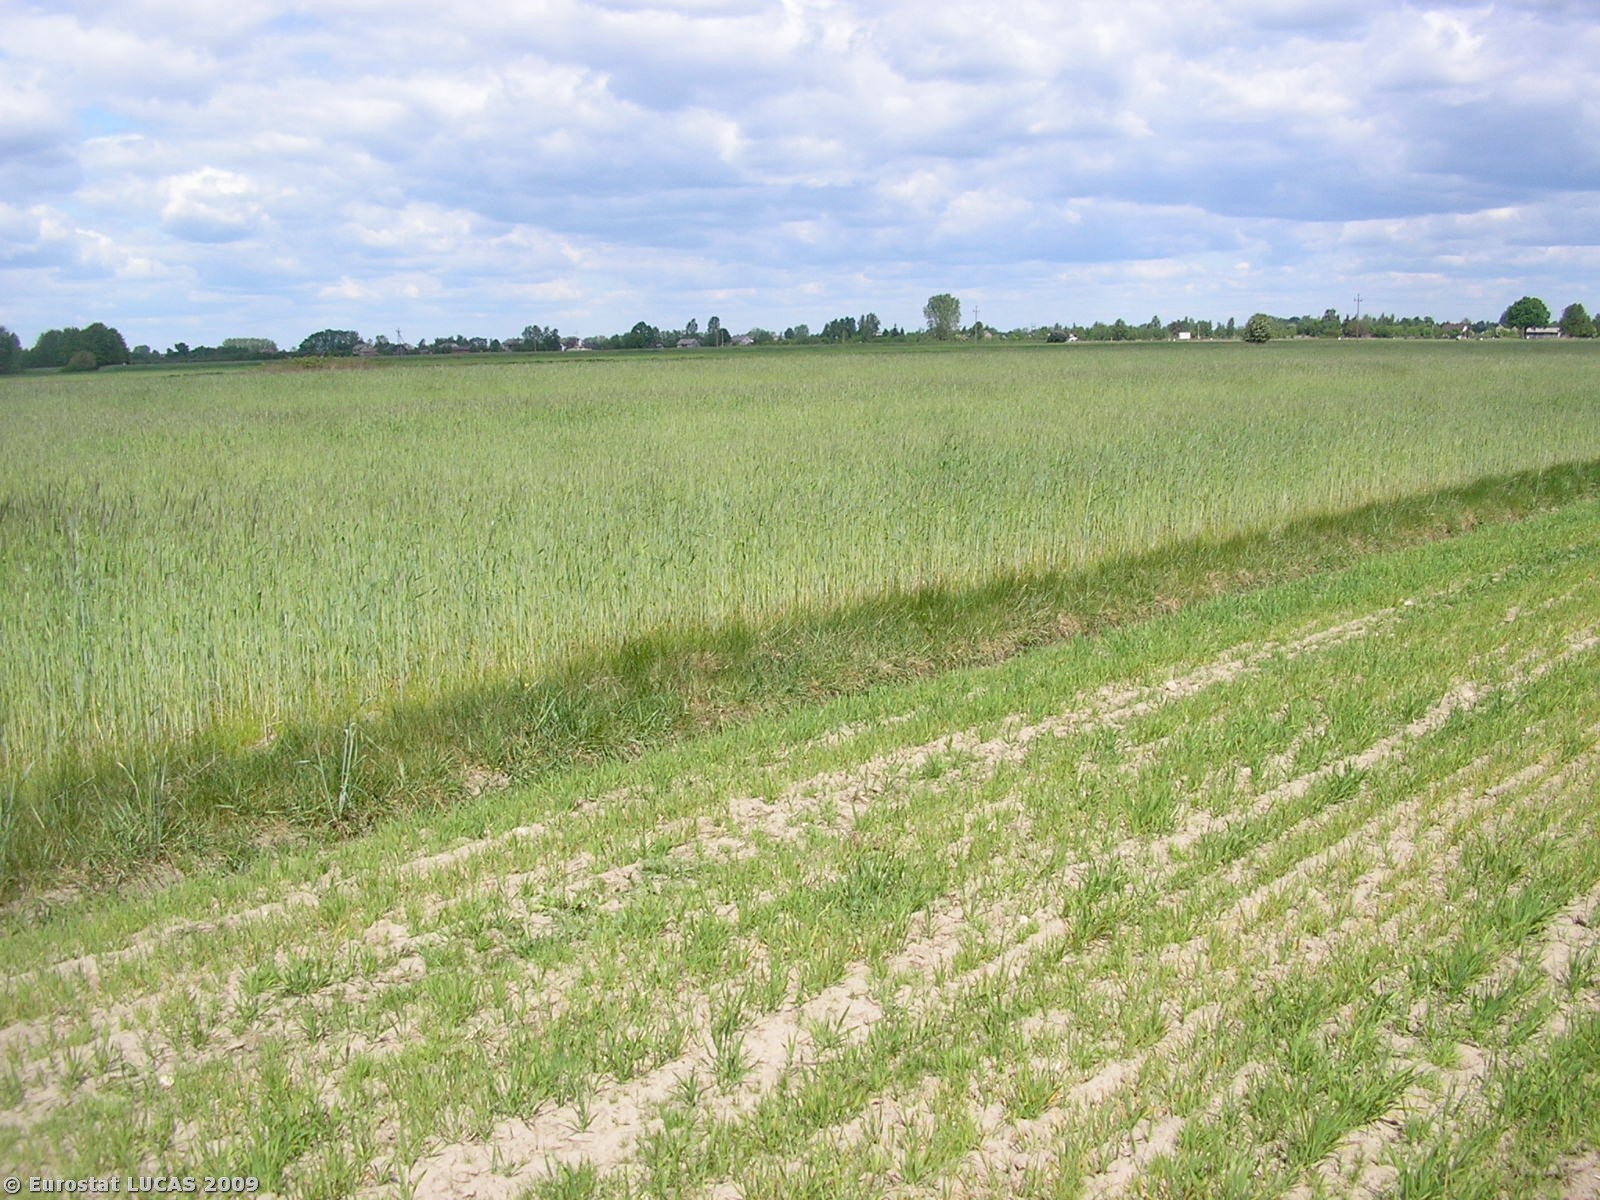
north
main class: Cropland
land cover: Oats
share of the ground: 10 - 25 %
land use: Agriculture (excluding fallow land and kitchen gardens)
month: May
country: PL
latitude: 51.9848
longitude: 20.0659
